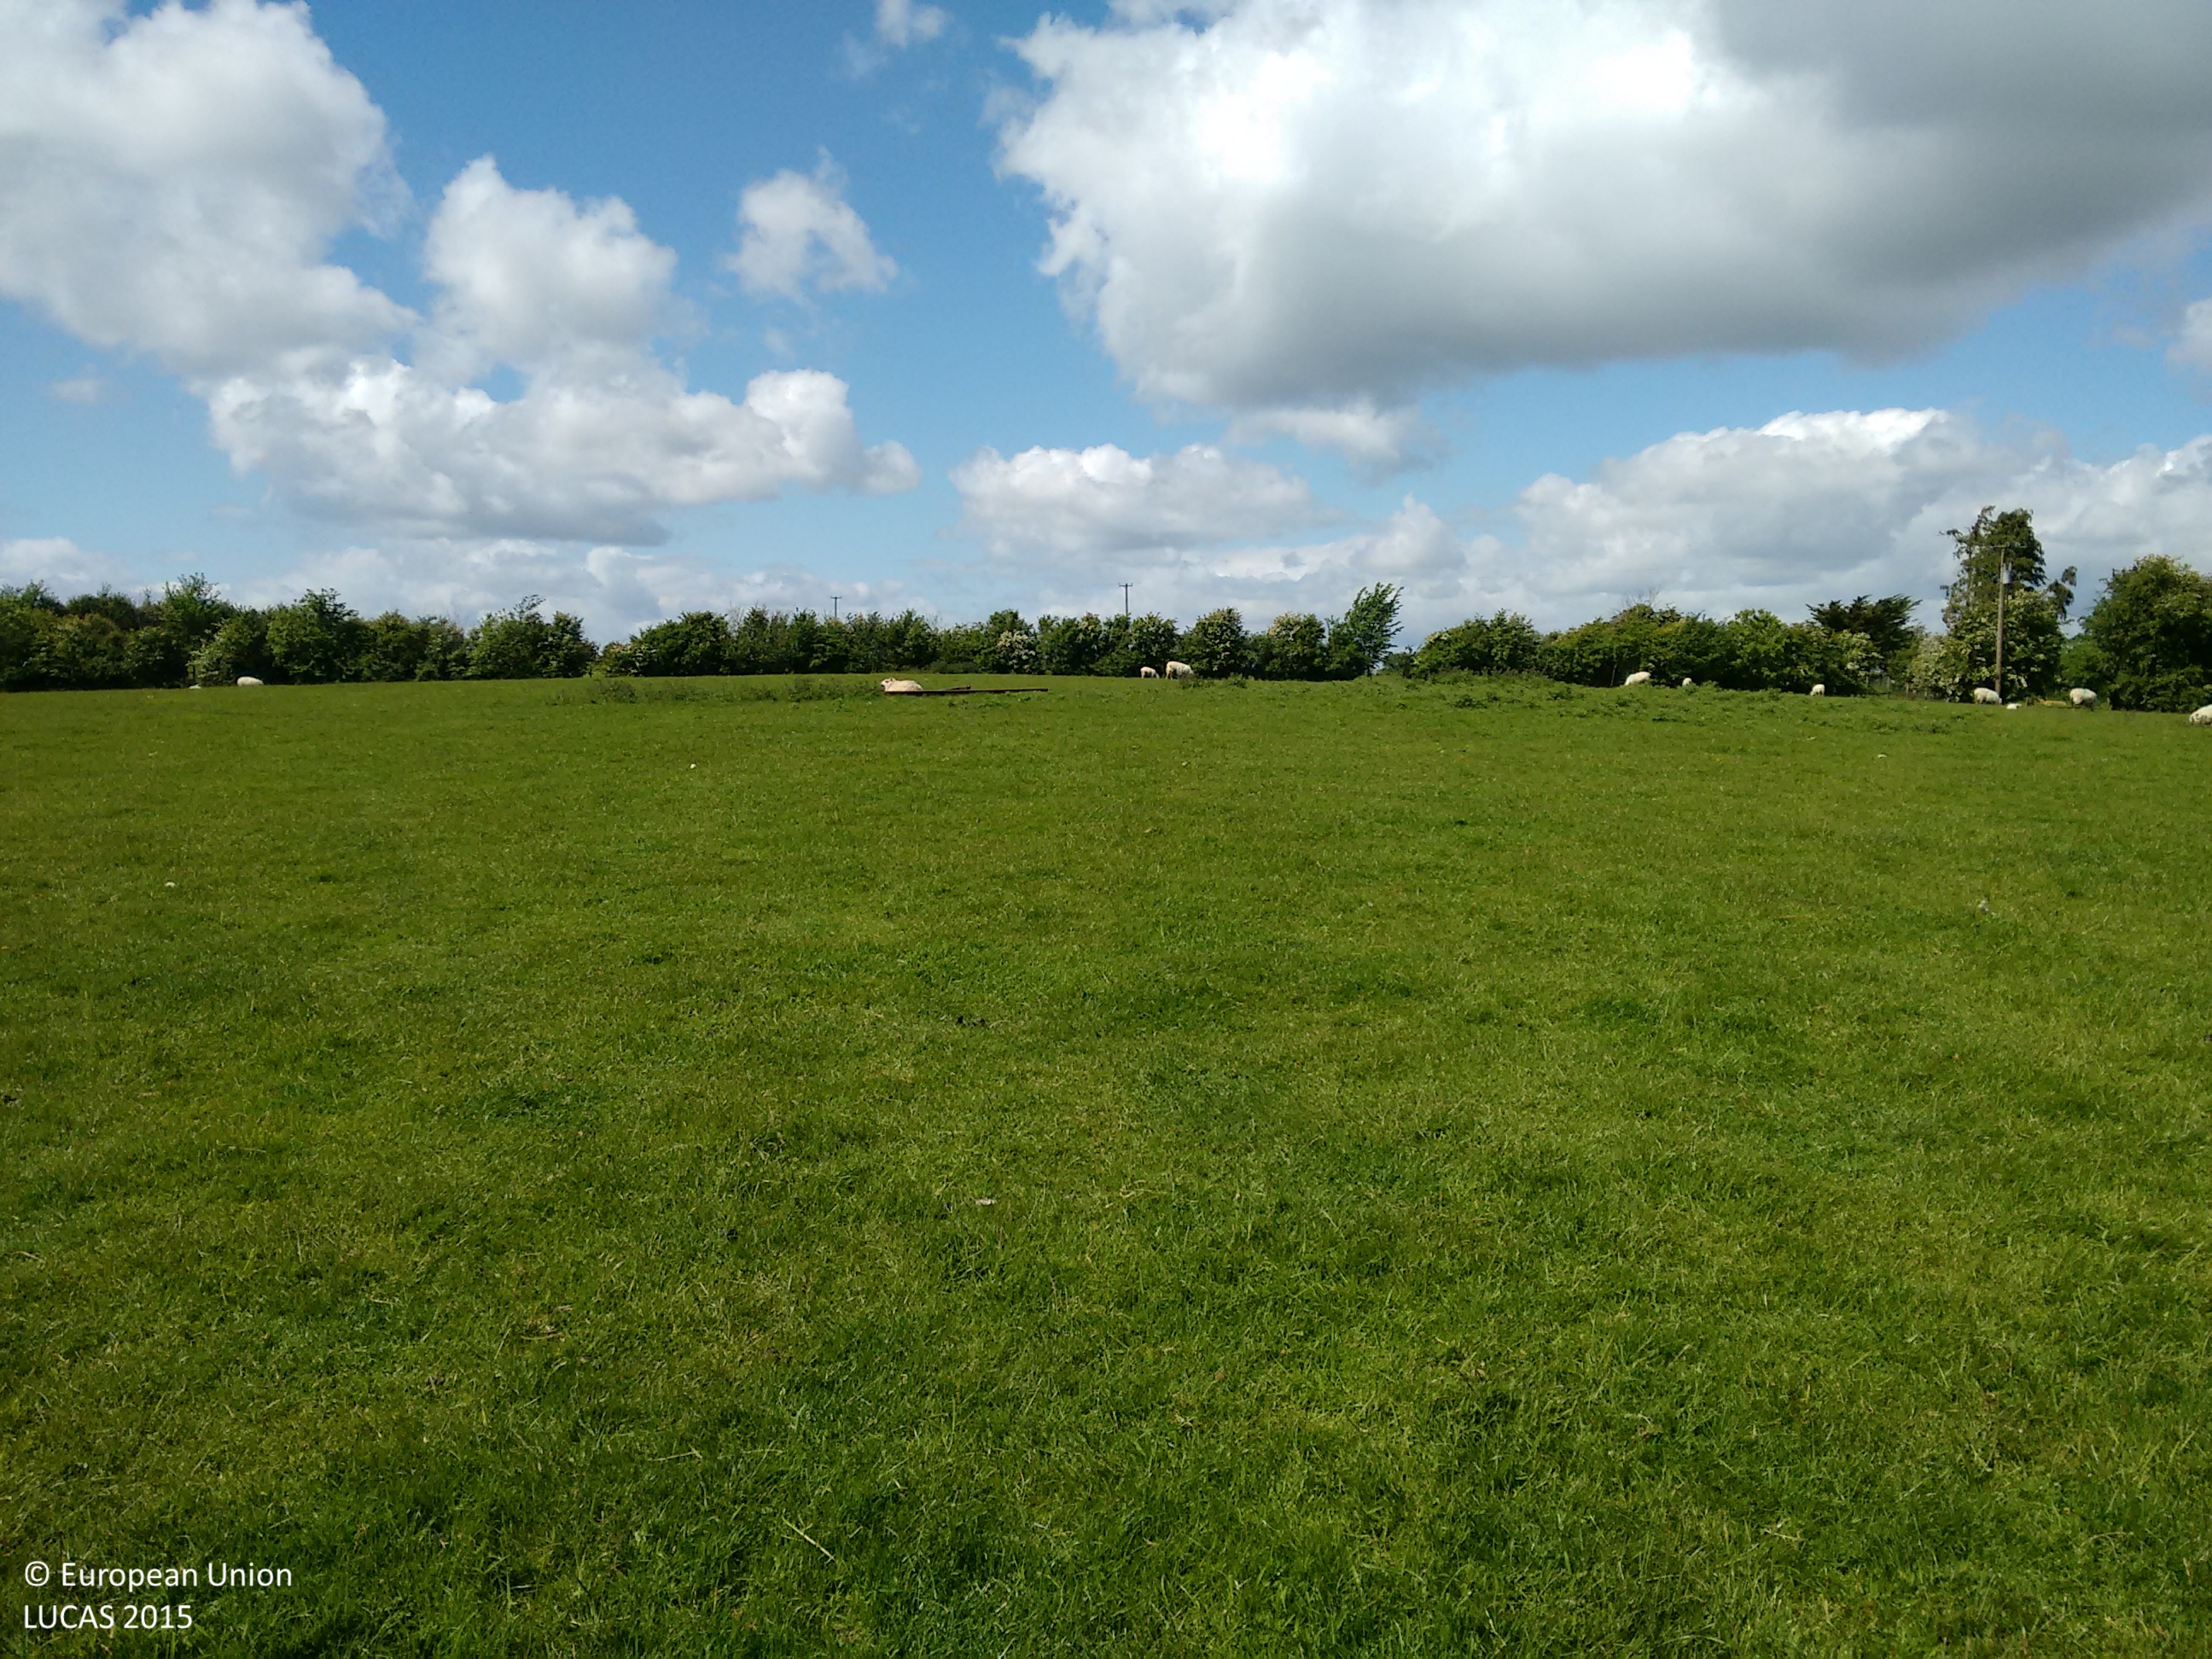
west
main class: Grassland
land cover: Grassland without tree/shrub cover
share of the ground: > 75 %
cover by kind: herbaceous plants 100 %
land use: Agriculture (excluding fallow land and kitchen gardens)
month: June
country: IE
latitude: 53.4400
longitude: -6.9872
